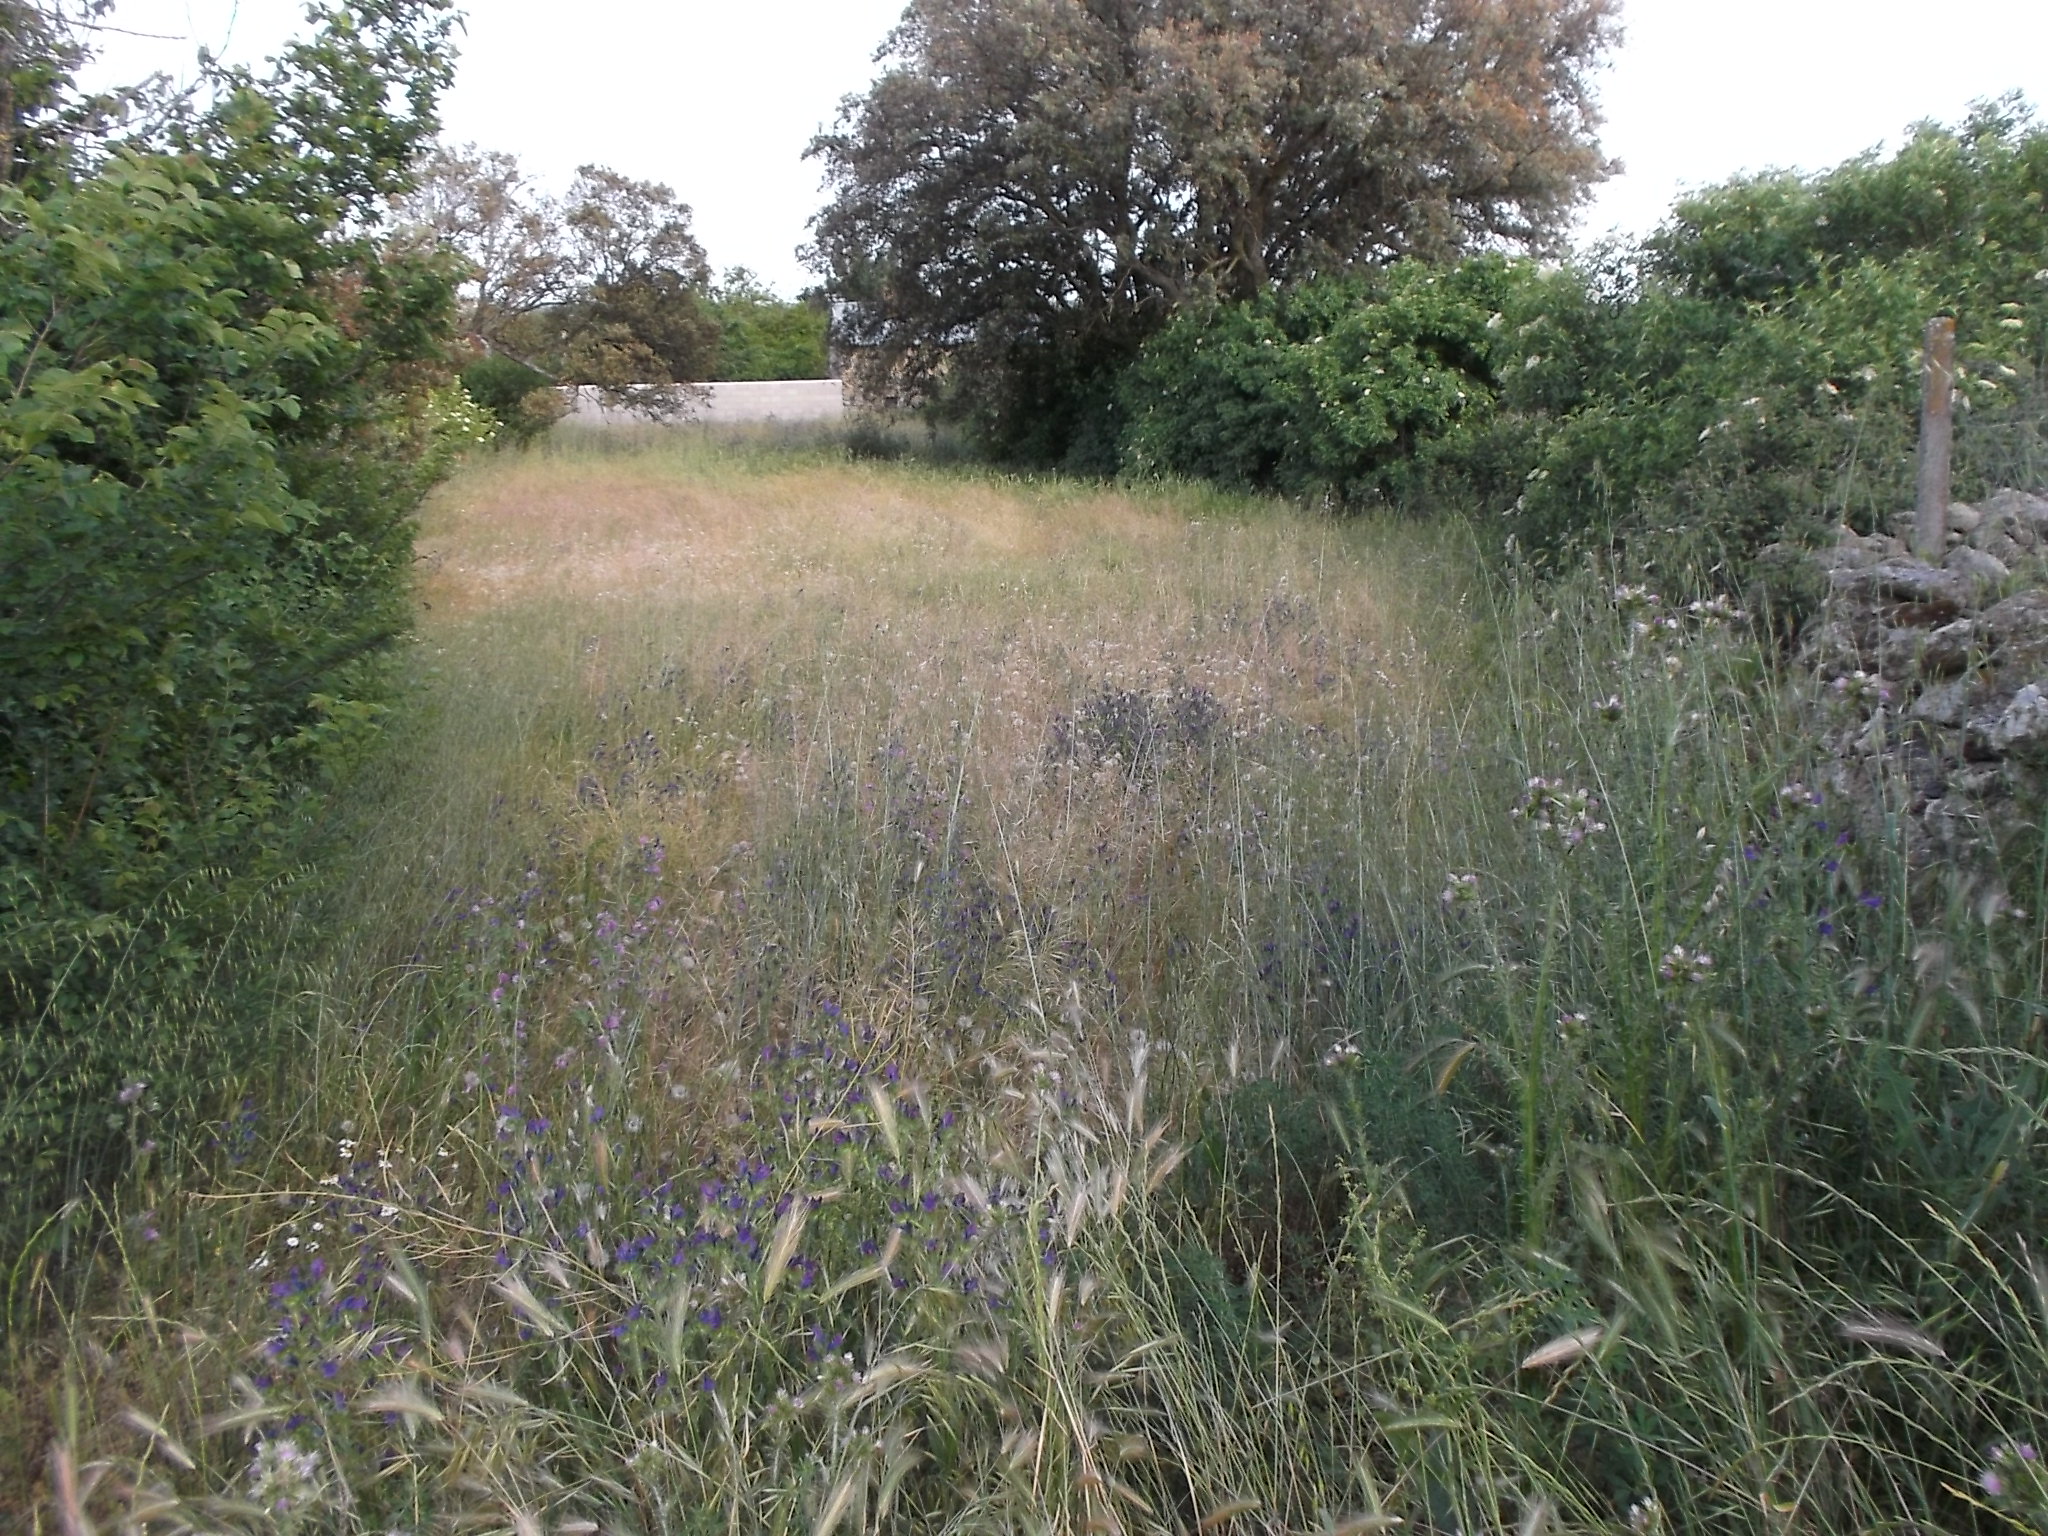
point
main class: Grassland
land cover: Grassland without tree/shrub cover
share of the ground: > 75 %
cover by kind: herbaceous plants 100 %
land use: Agriculture (excluding fallow land and kitchen gardens)
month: May
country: ES
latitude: 41.1127
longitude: -6.3491
